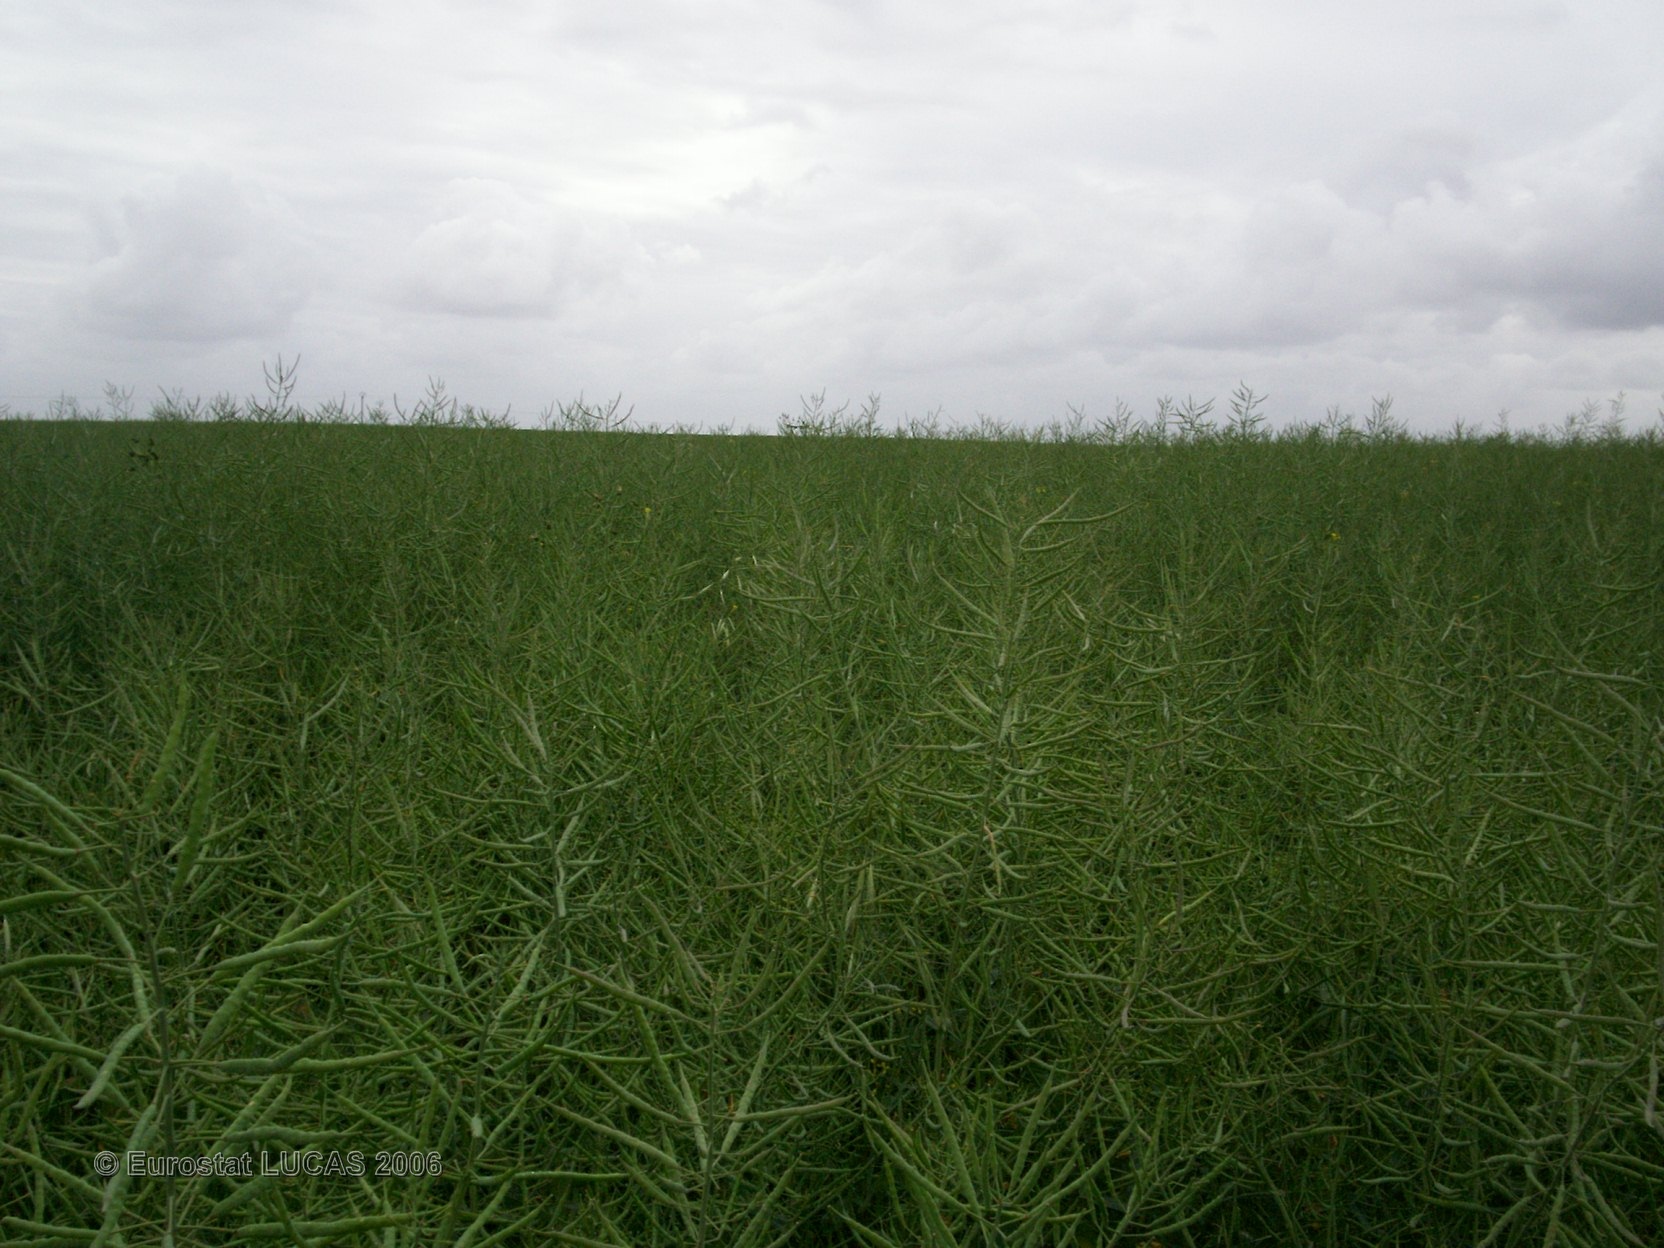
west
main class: Cropland
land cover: Rape and turnip rape
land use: Agriculture (excluding fallow land and kitchen gardens)
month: May
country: FR
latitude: 46.3629
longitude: -0.2788
